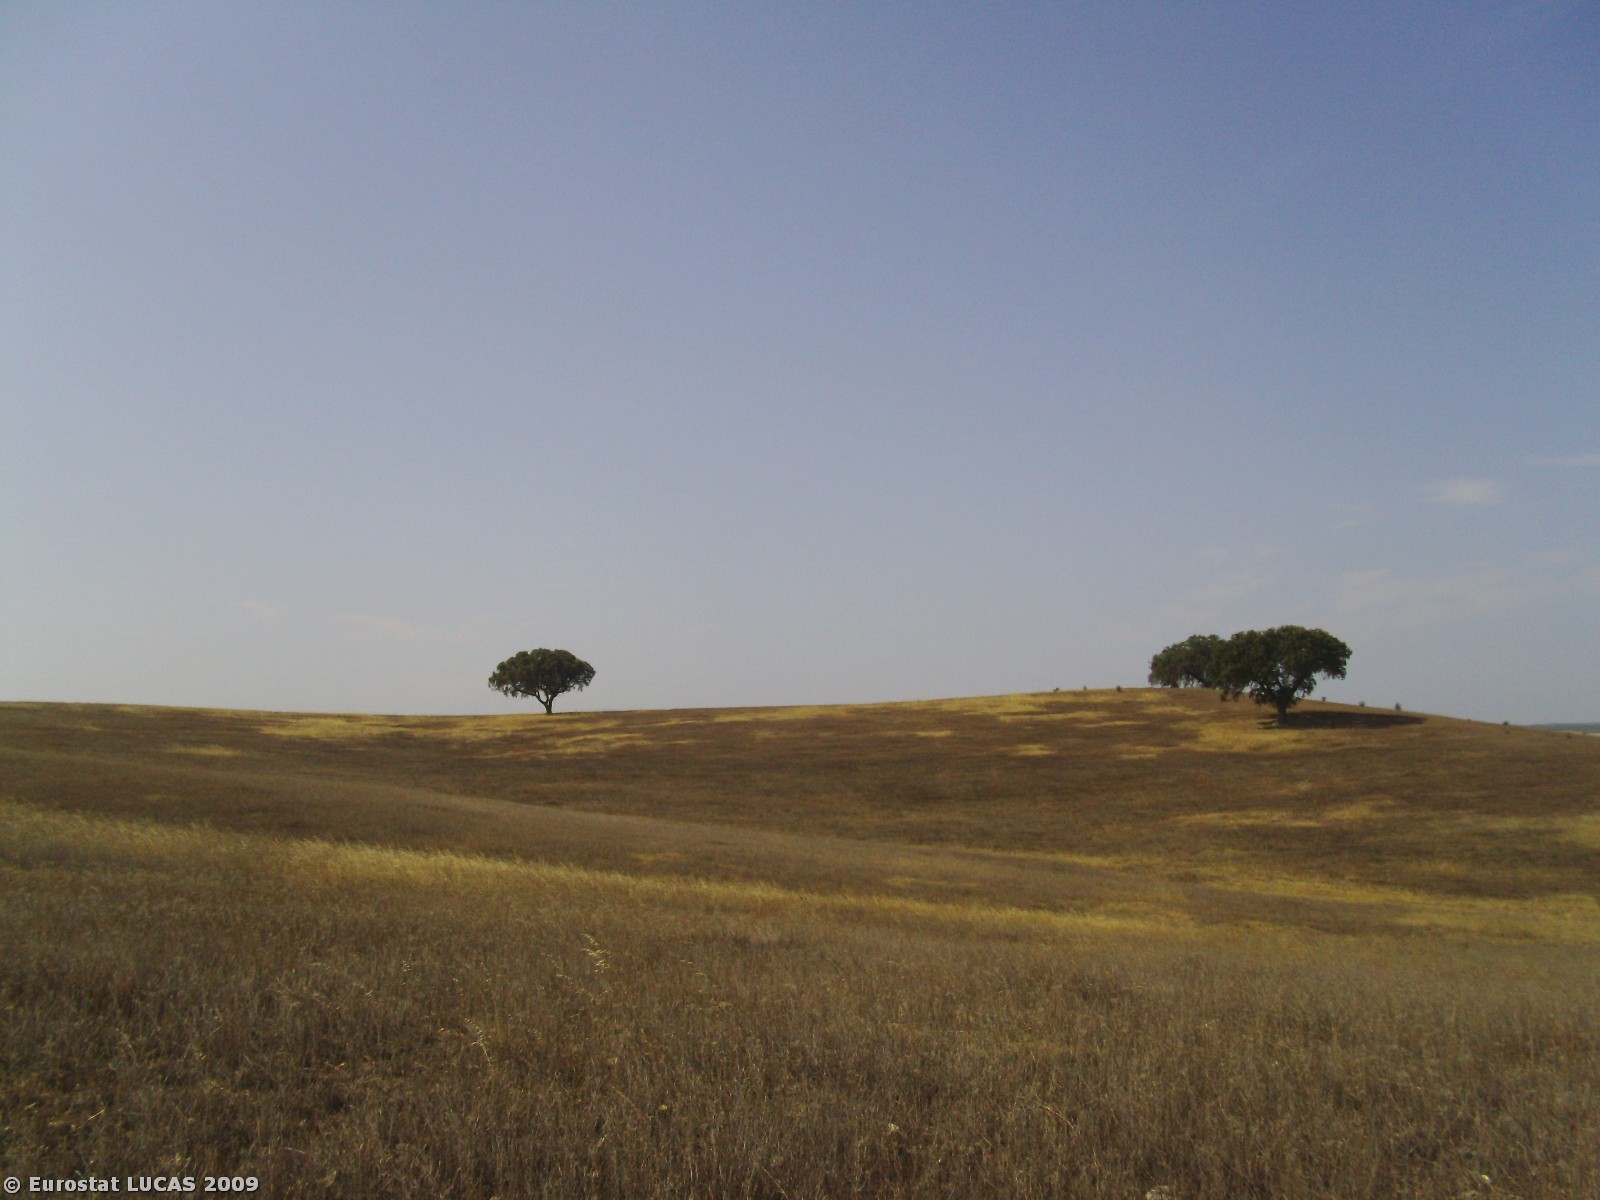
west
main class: Grassland
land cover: Spontaneously vegetated surfaces
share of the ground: 50 - 75 %
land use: Fallow land
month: August
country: PT
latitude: 38.4115
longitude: -7.6557
